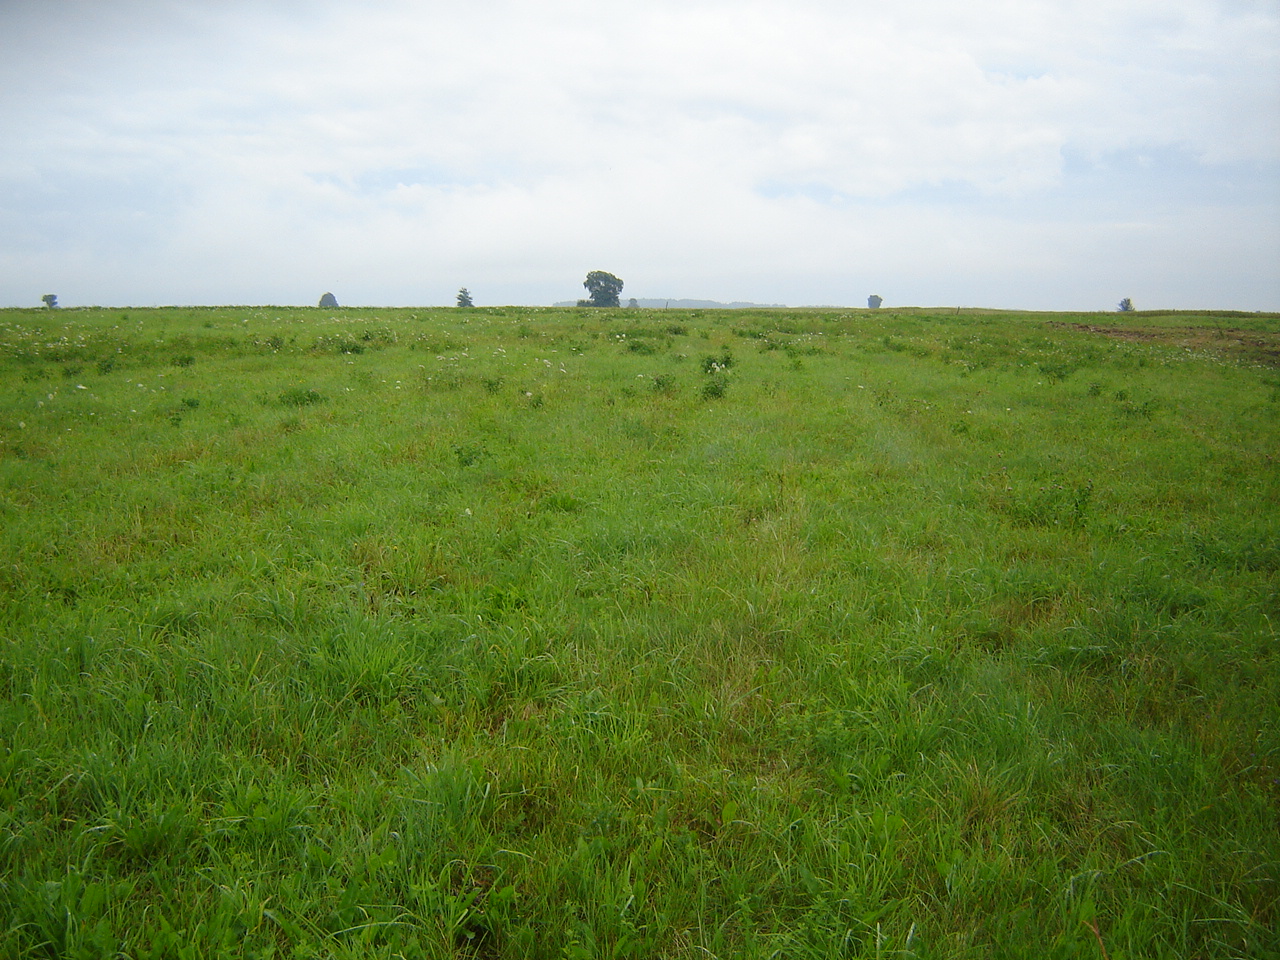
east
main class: Grassland
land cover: Grassland without tree/shrub cover
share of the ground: > 75 %
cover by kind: herbaceous plants 100 %
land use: Agriculture (excluding fallow land and kitchen gardens)
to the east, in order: Grassland without tree/shrub cover; Common wheat
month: July
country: LT
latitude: 55.4355
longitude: 25.0812
